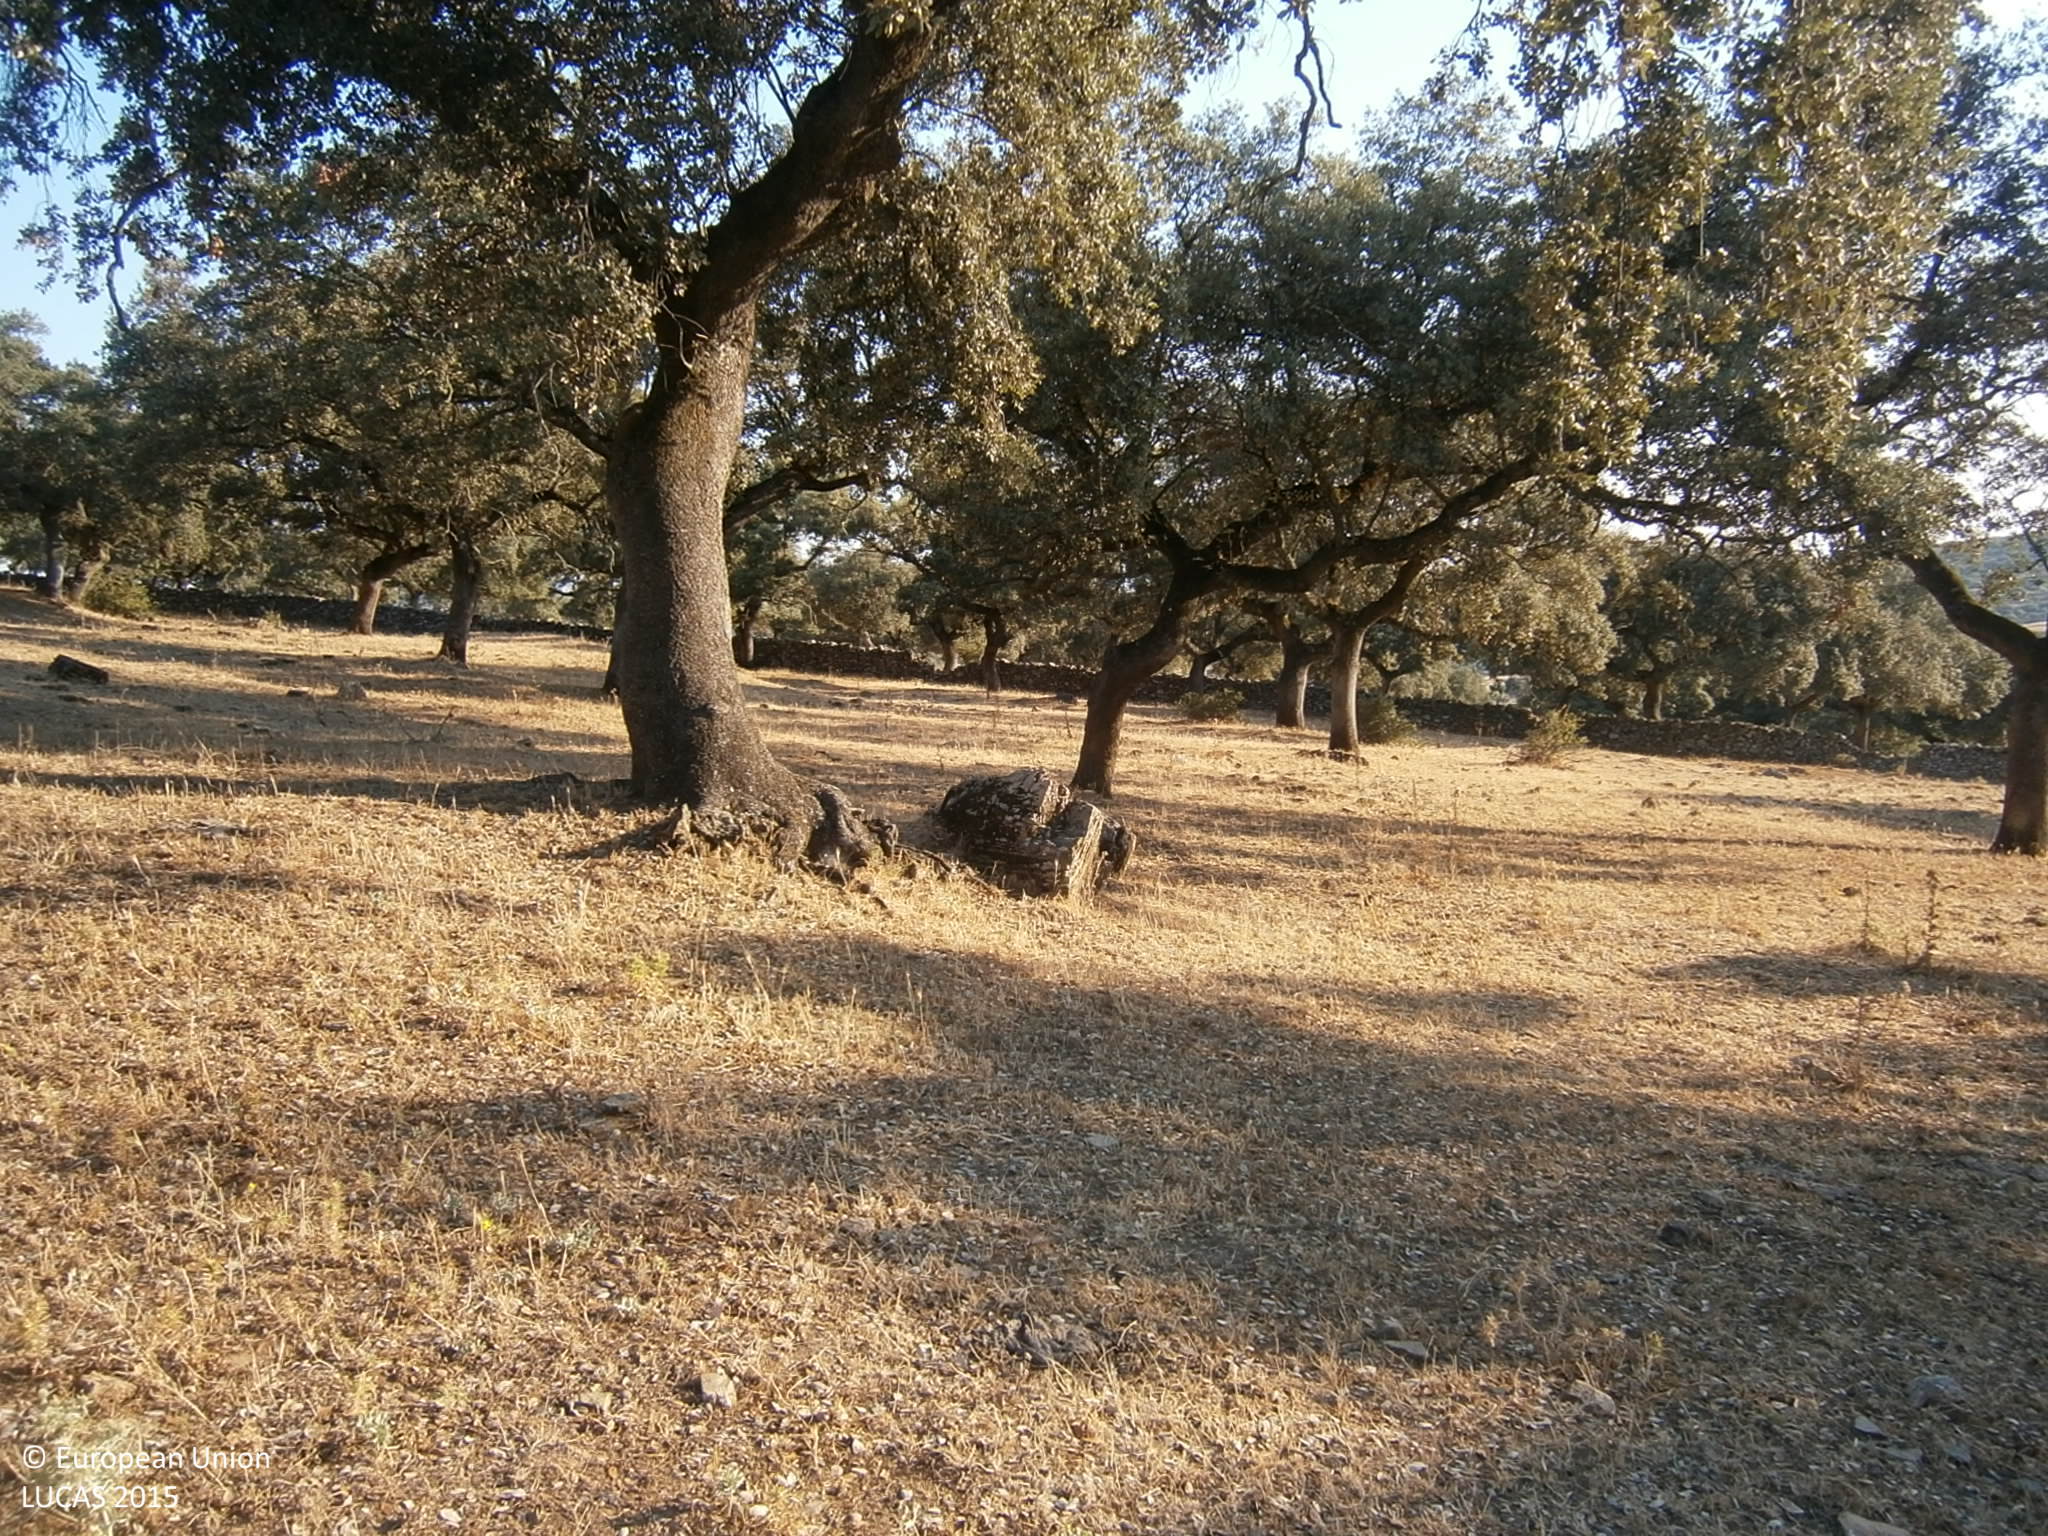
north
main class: Woodland
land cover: Broadleaved woodland
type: broadleaved evergreen forest
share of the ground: > 75 %
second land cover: Spontaneously vegetated surfaces
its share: 50 - 75 %
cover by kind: herbaceous plants 70 %, broadleaved forest trees 10 %, unconsolidated bare surface 10 %, shrubs 5 %
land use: Forestry
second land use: Agriculture (excluding fallow land and kitchen gardens)
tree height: > 5 m
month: June
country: ES
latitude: 38.5839
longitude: -6.8100
